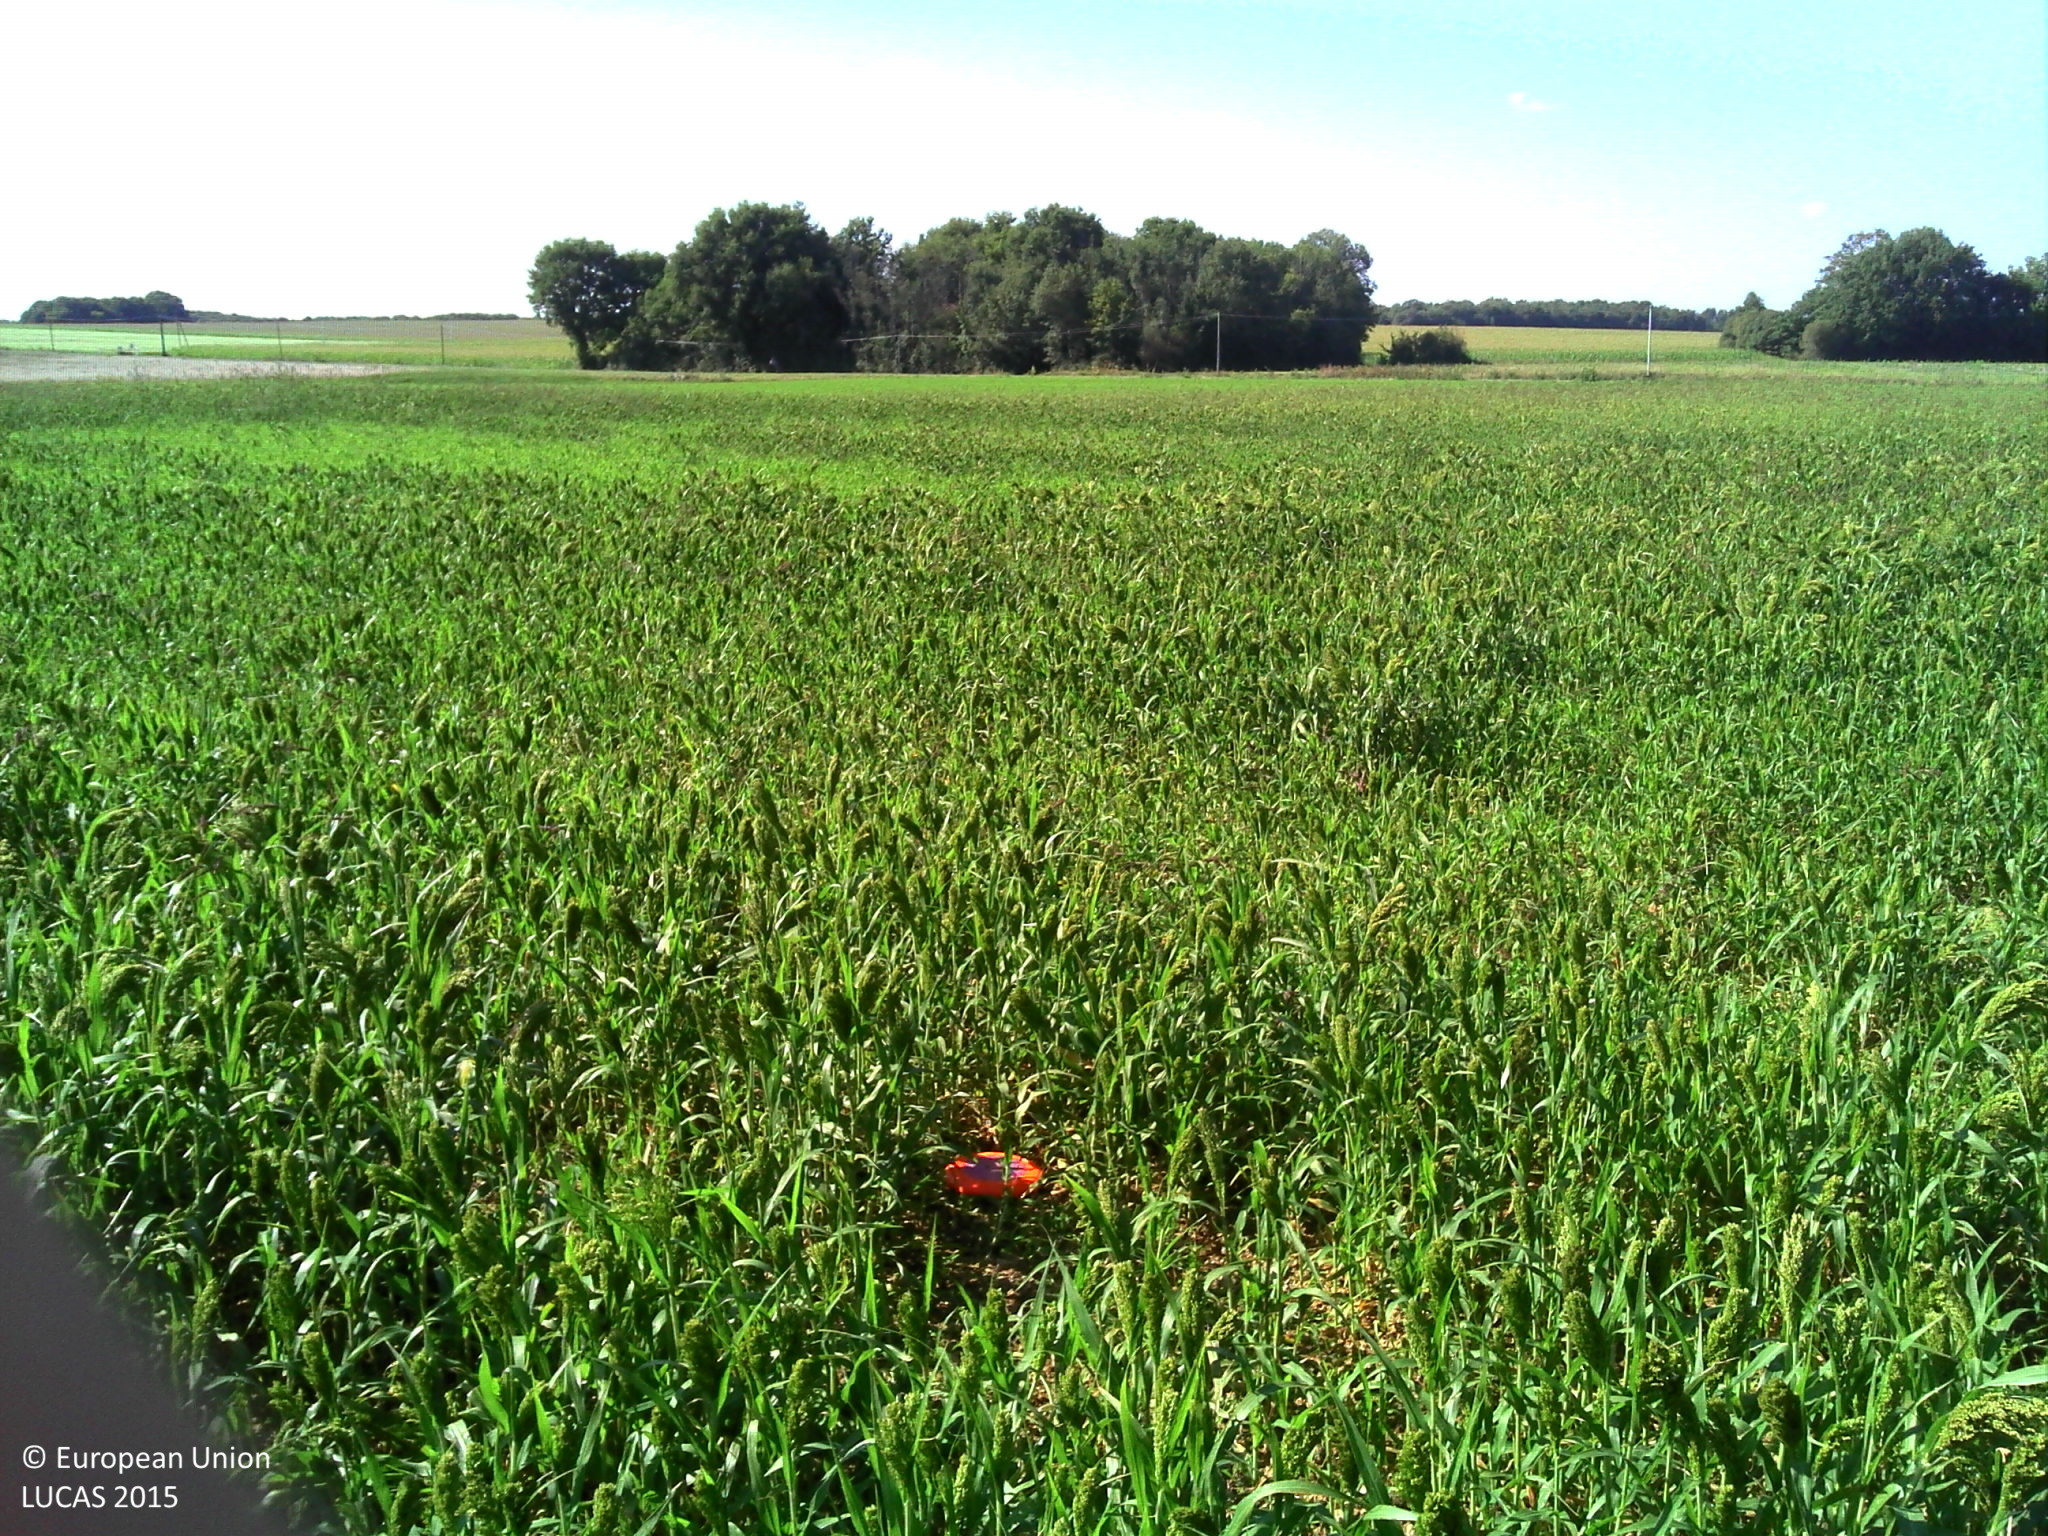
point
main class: Cropland
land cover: Other cereals
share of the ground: > 75 %
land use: Agriculture (excluding fallow land and kitchen gardens)
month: September
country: FR
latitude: 46.9746
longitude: 1.0860
